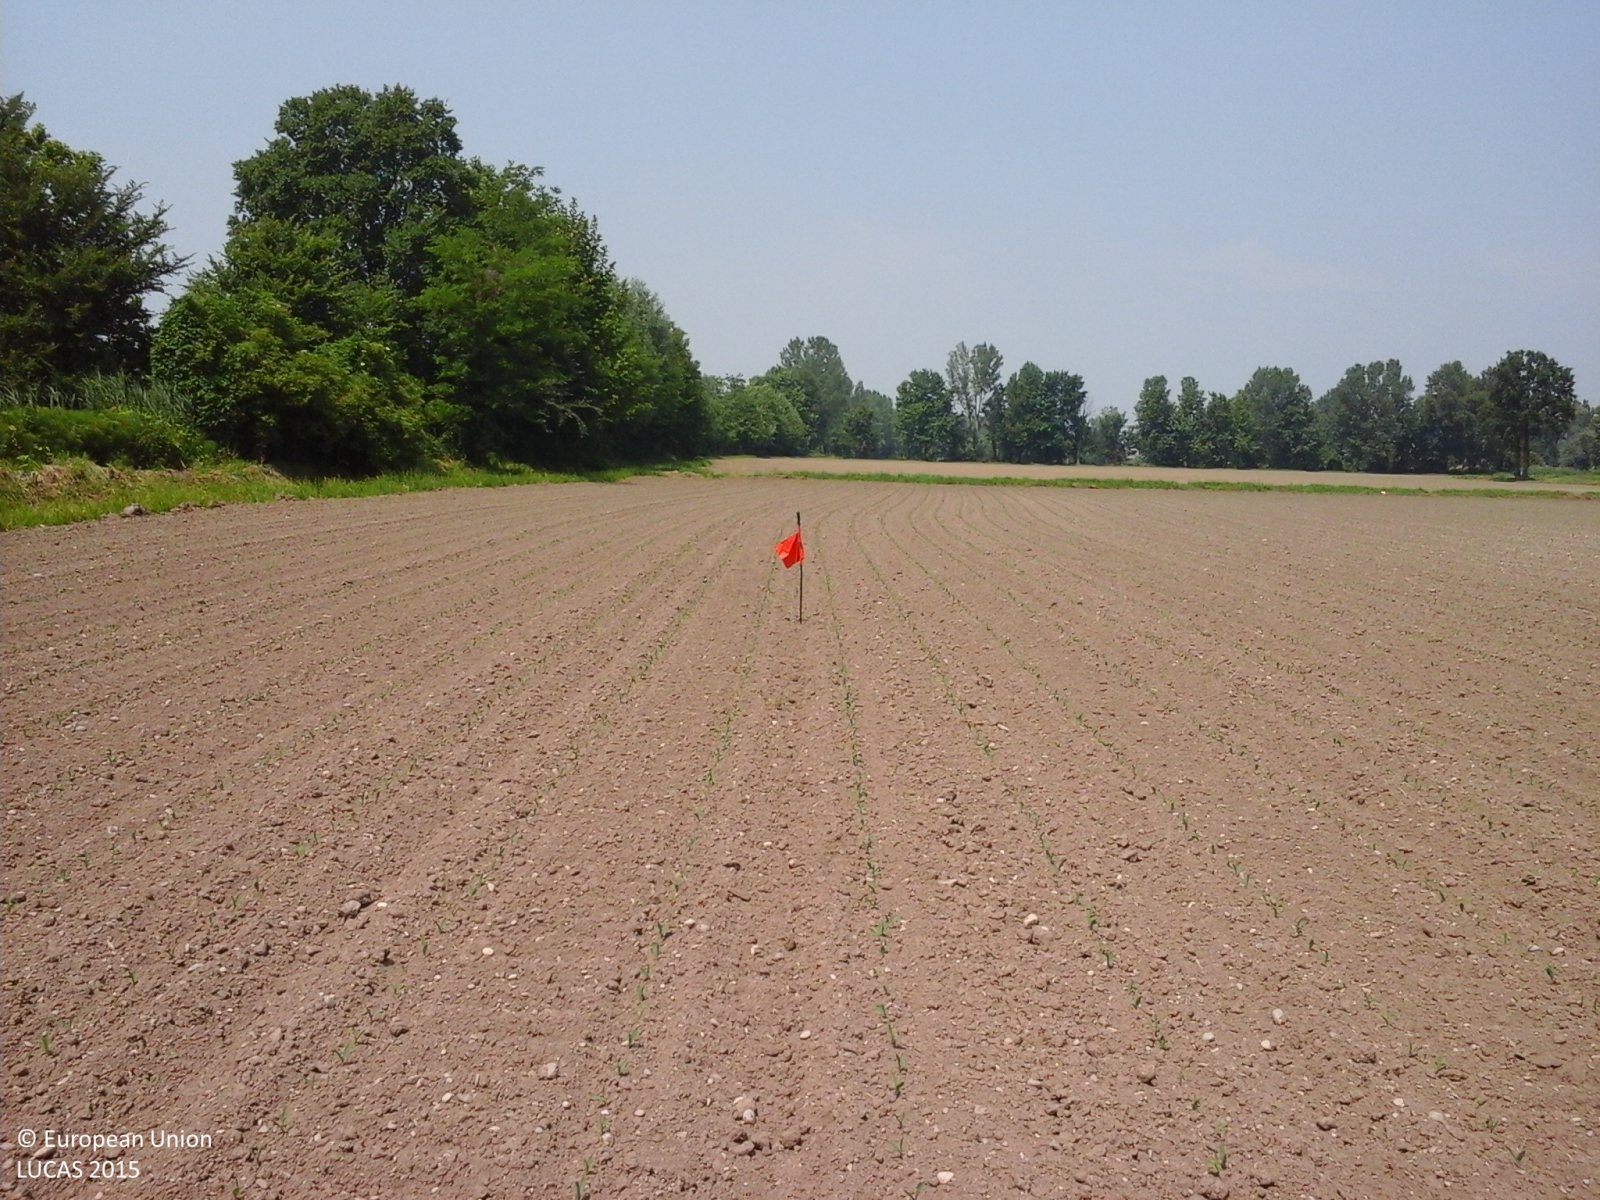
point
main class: Cropland
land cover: Maize
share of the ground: < 10 %
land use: Agriculture (excluding fallow land and kitchen gardens)
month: June
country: IT
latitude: 45.3781
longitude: 10.1912
